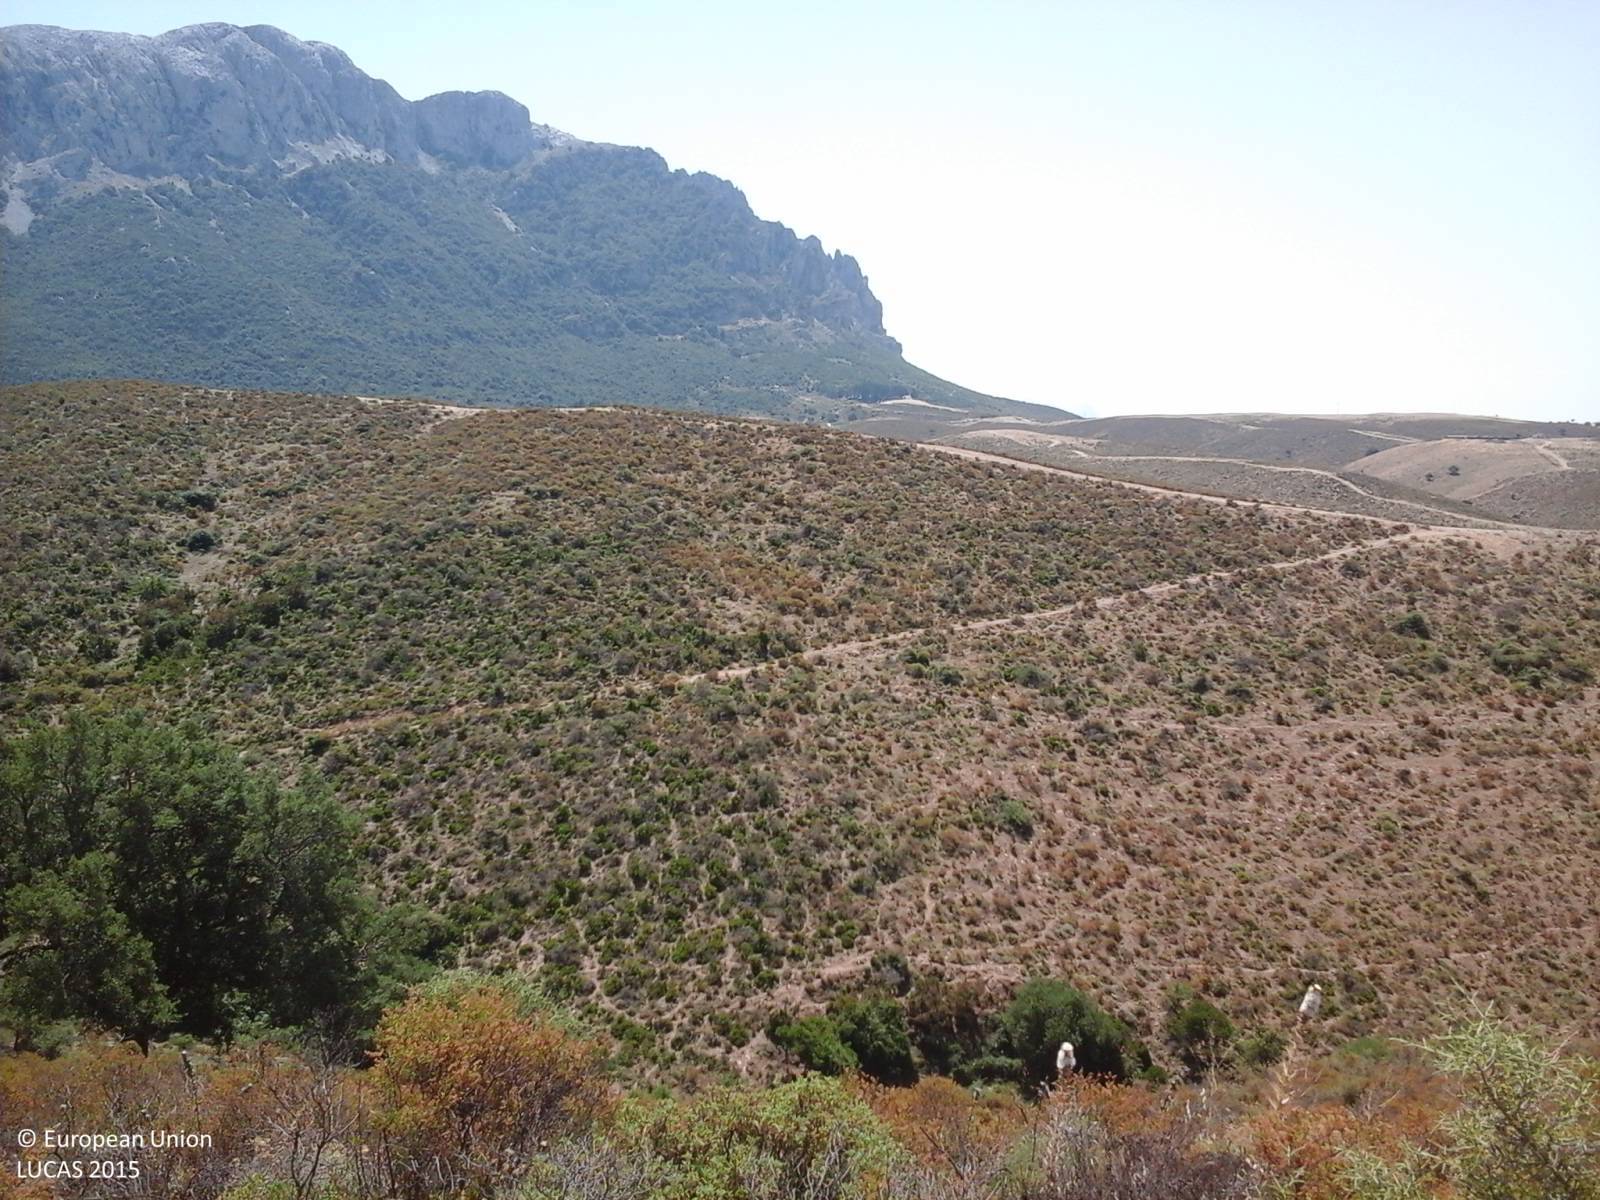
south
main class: Shrubland
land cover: Shrubland without tree cover
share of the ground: > 75 %
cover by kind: shrubs 95 %, herbaceous plants 5 %
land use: Semi-natural and natural areas not in use
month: July
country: IT
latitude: 40.4834
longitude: 9.5188
